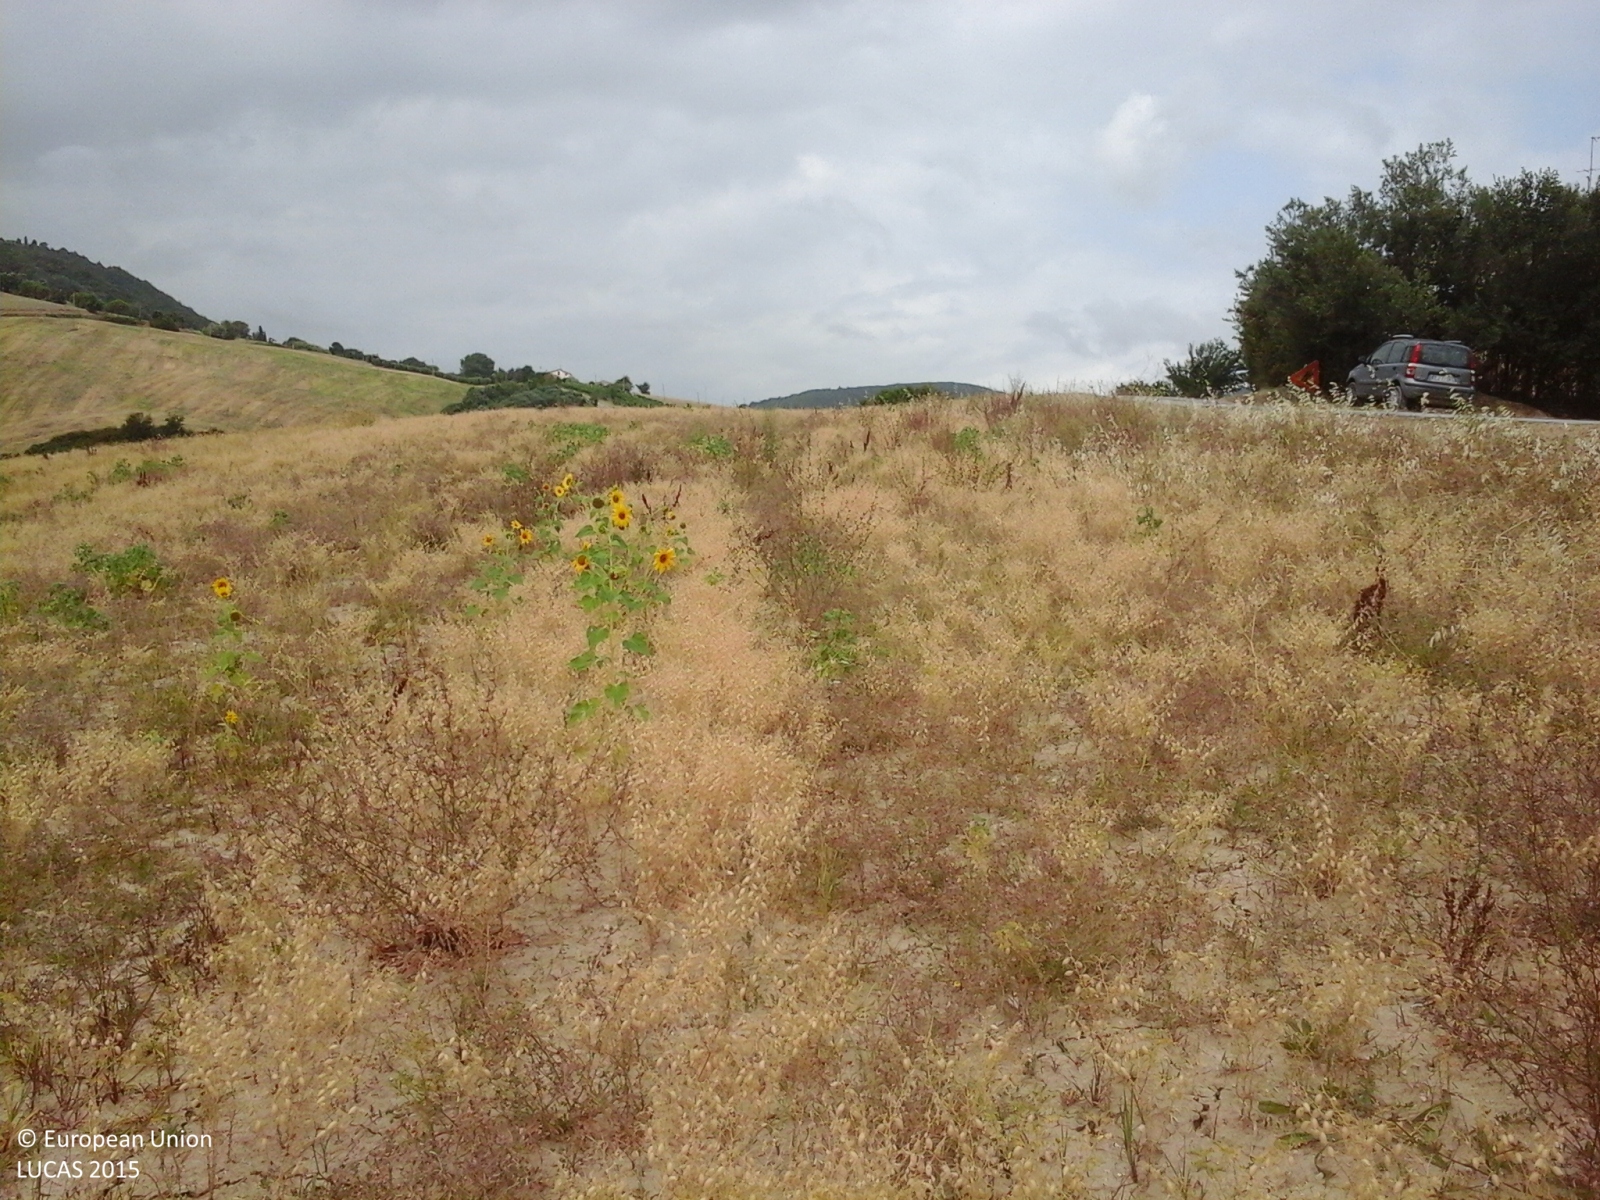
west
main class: Cropland
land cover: Dry pulses
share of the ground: > 75 %
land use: Agriculture (excluding fallow land and kitchen gardens)
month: July
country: IT
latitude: 43.2883
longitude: 13.2575
